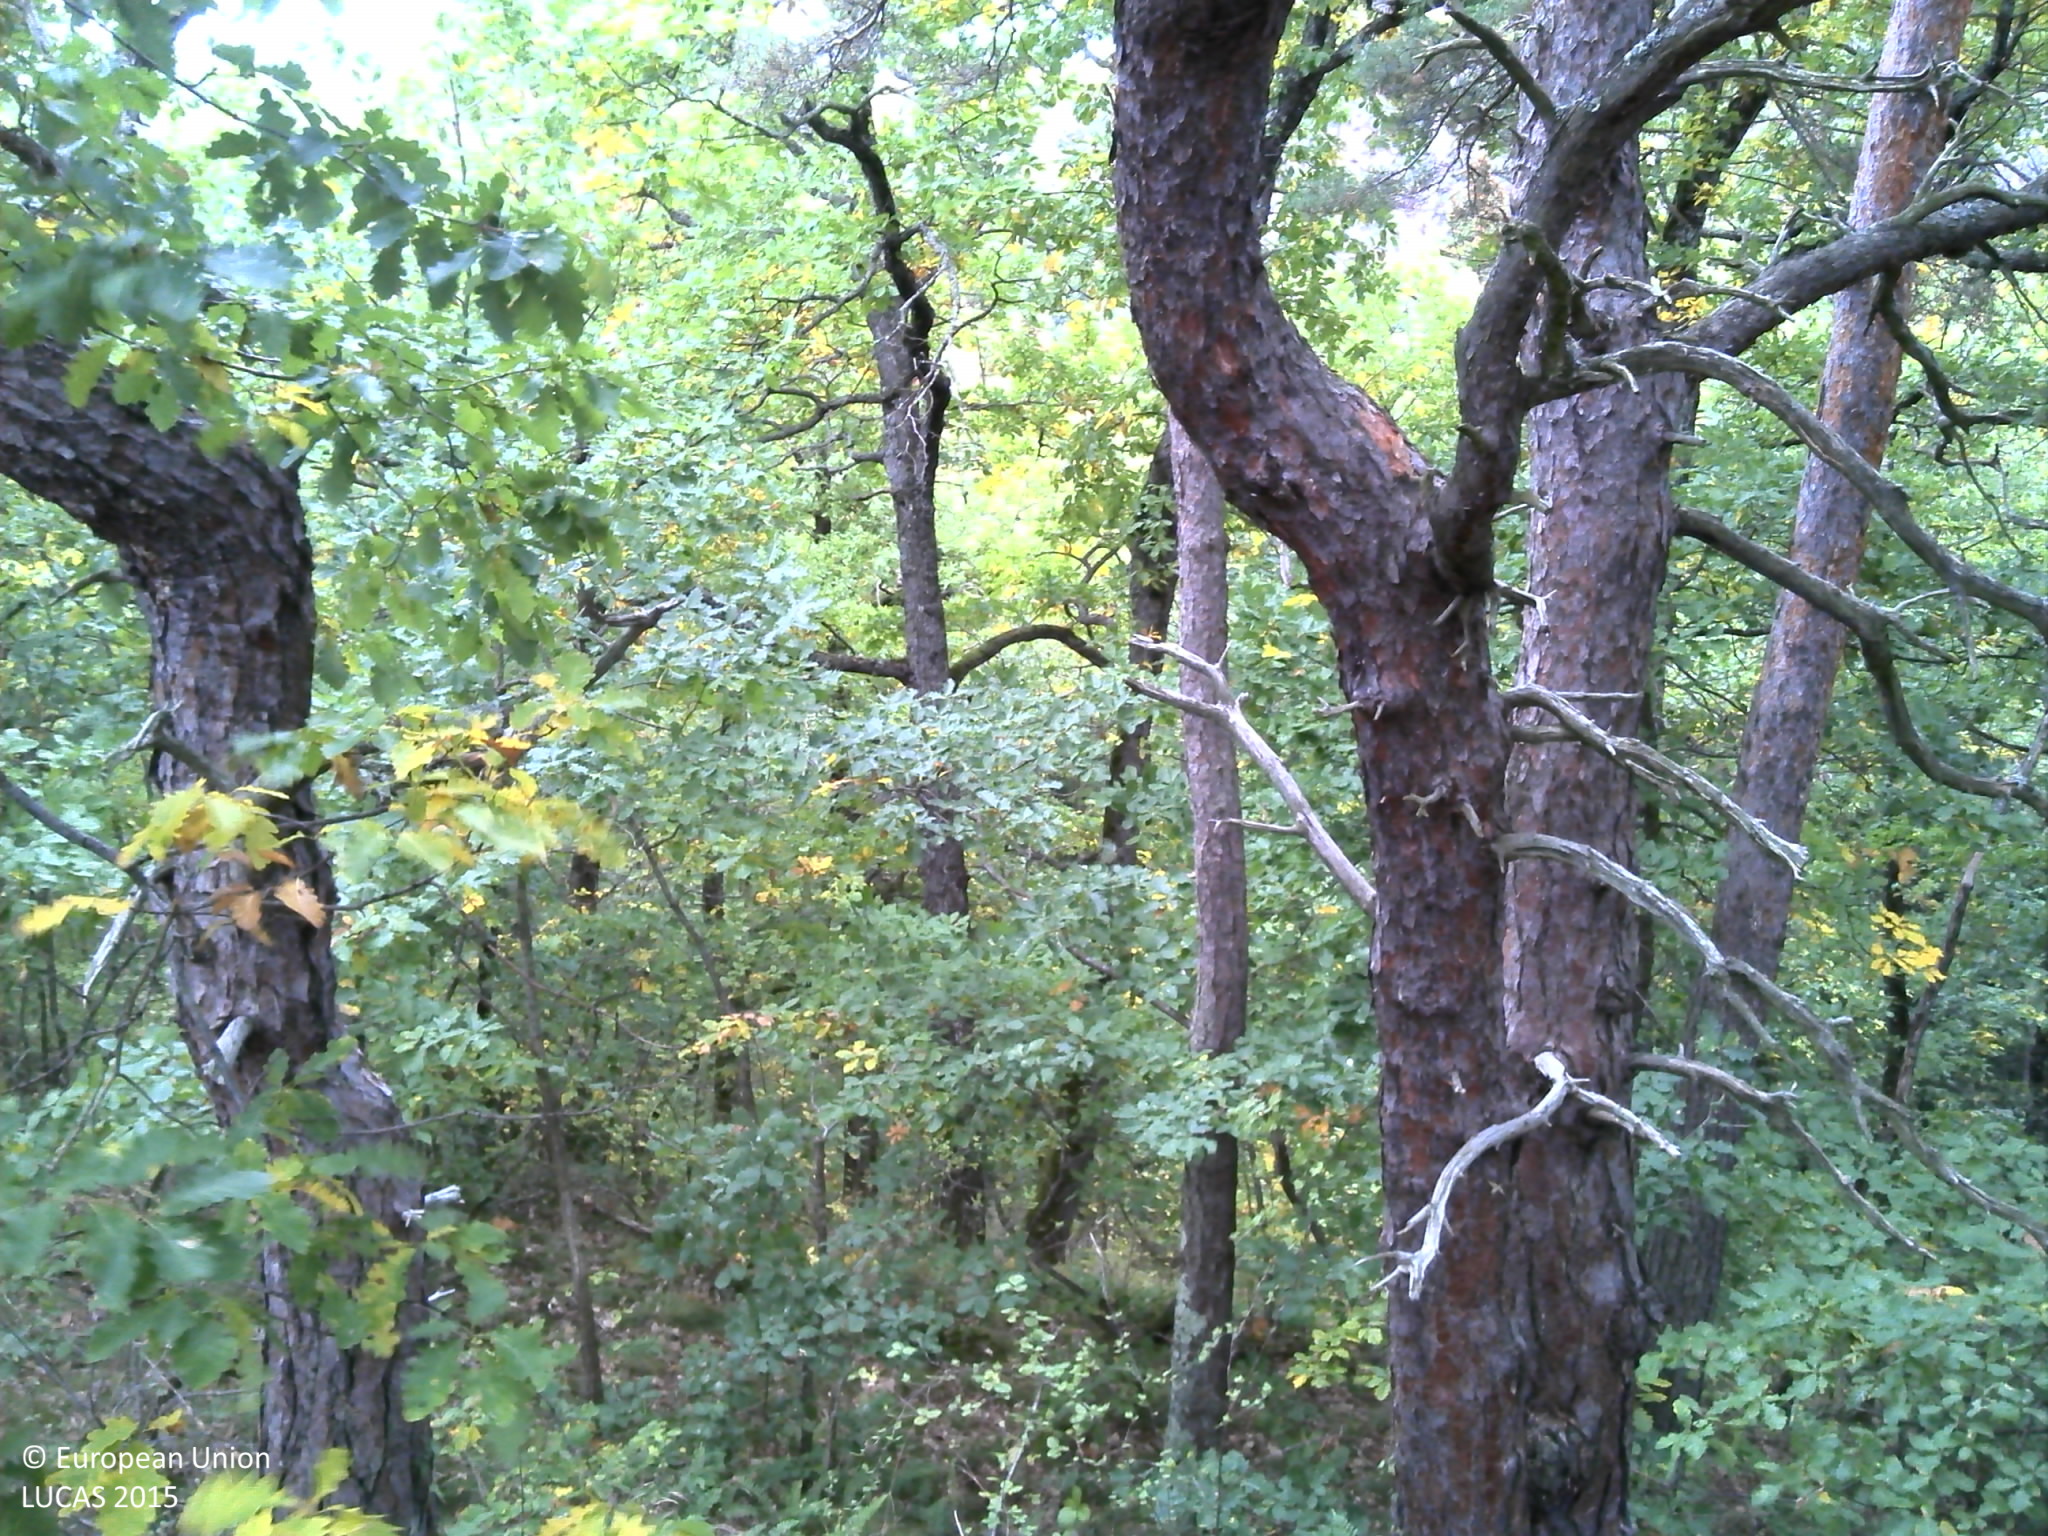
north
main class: Woodland
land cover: Pine dominated mixed woodland
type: alpine coniferous forest
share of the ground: > 75 %
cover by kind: coniferous forest trees 50 %, broadleaved forest trees 25 %, herbaceous plants 15 %, unconsolidated bare surface 10 %
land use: Forestry
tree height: > 5 m
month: October
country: FR
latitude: 45.4061
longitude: 3.1145
